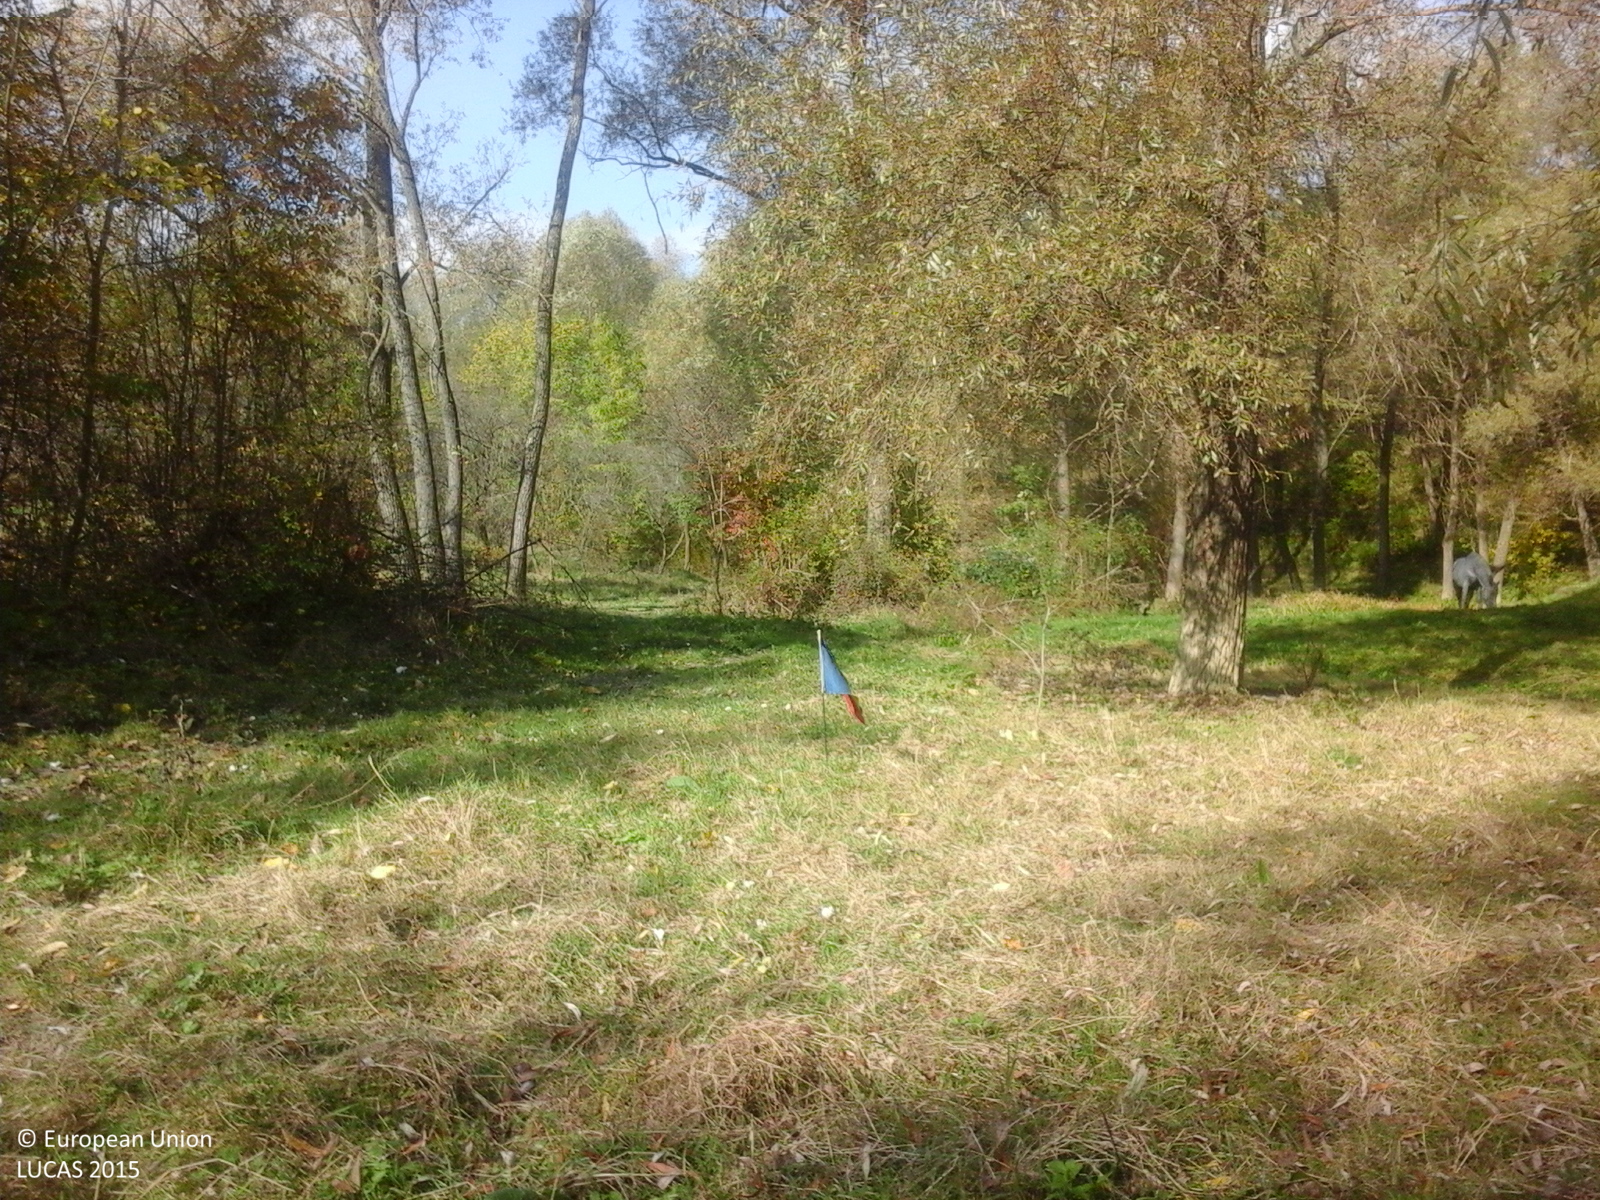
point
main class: Woodland
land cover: Broadleaved woodland
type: non-riverine alder, birch or aspen forest
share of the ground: > 75 %
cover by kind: broadleaved forest trees 100 %
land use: Forestry
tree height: > 5 m
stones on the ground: < 10 %
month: October
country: RO
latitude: 45.4886
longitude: 26.9108
